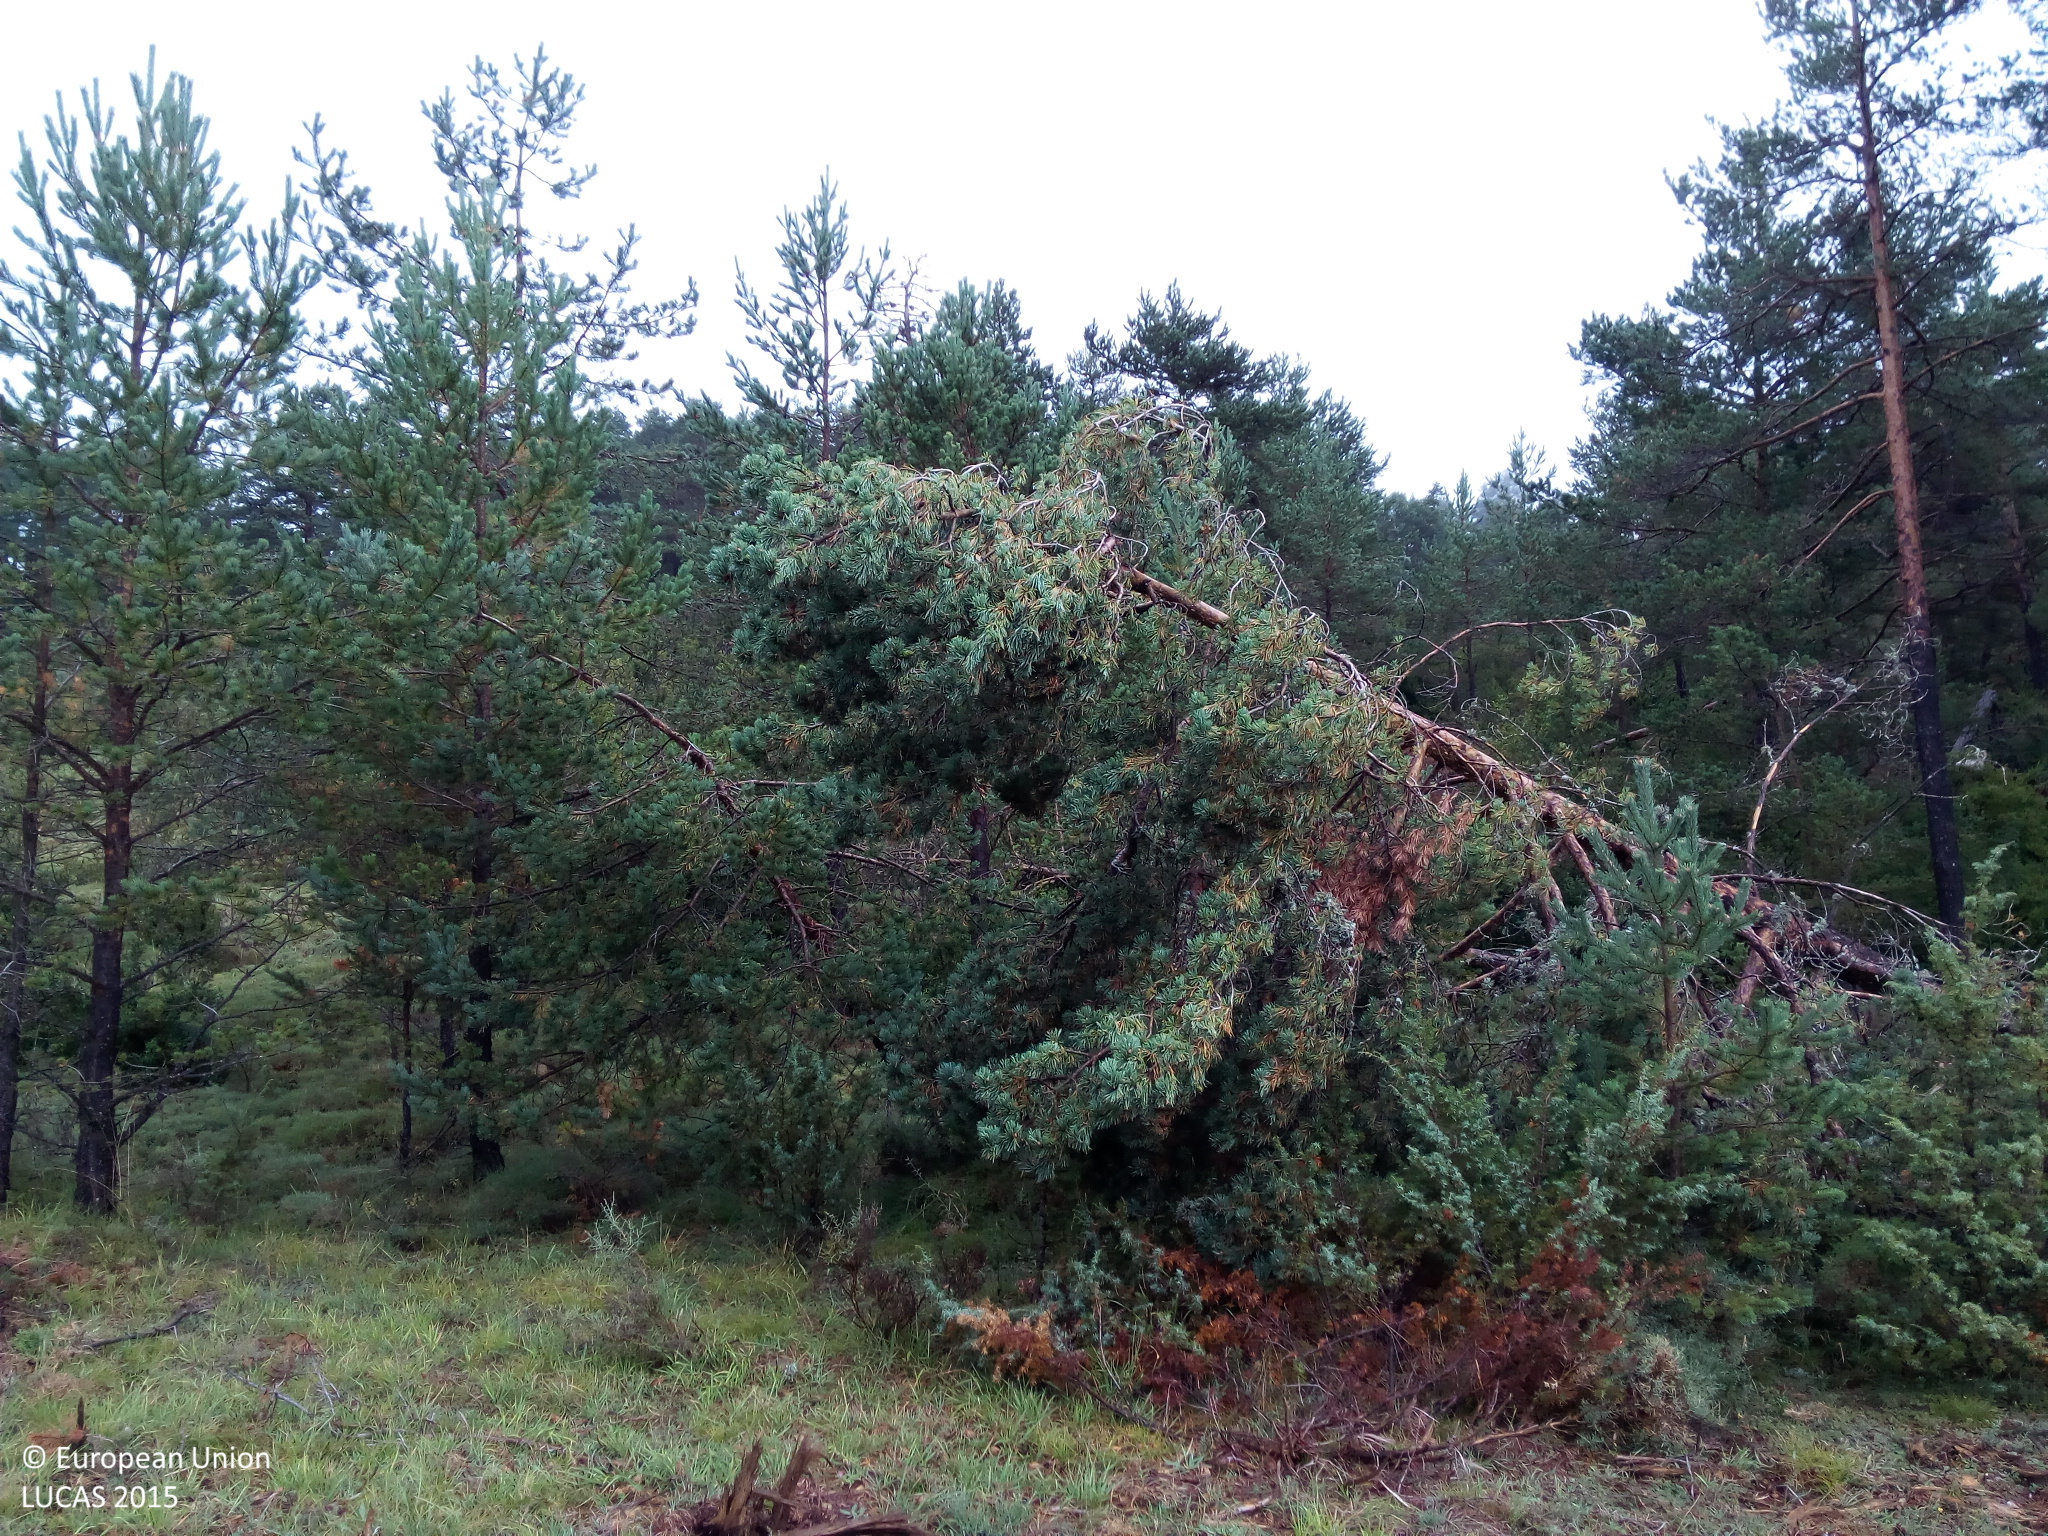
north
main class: Grassland
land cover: Grassland without tree/shrub cover
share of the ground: > 75 %
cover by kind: herbaceous plants 100 %
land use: Forestry
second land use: Agriculture (excluding fallow land and kitchen gardens)
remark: Clear cut
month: September
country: ES
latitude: 42.4055
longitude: -0.0707
